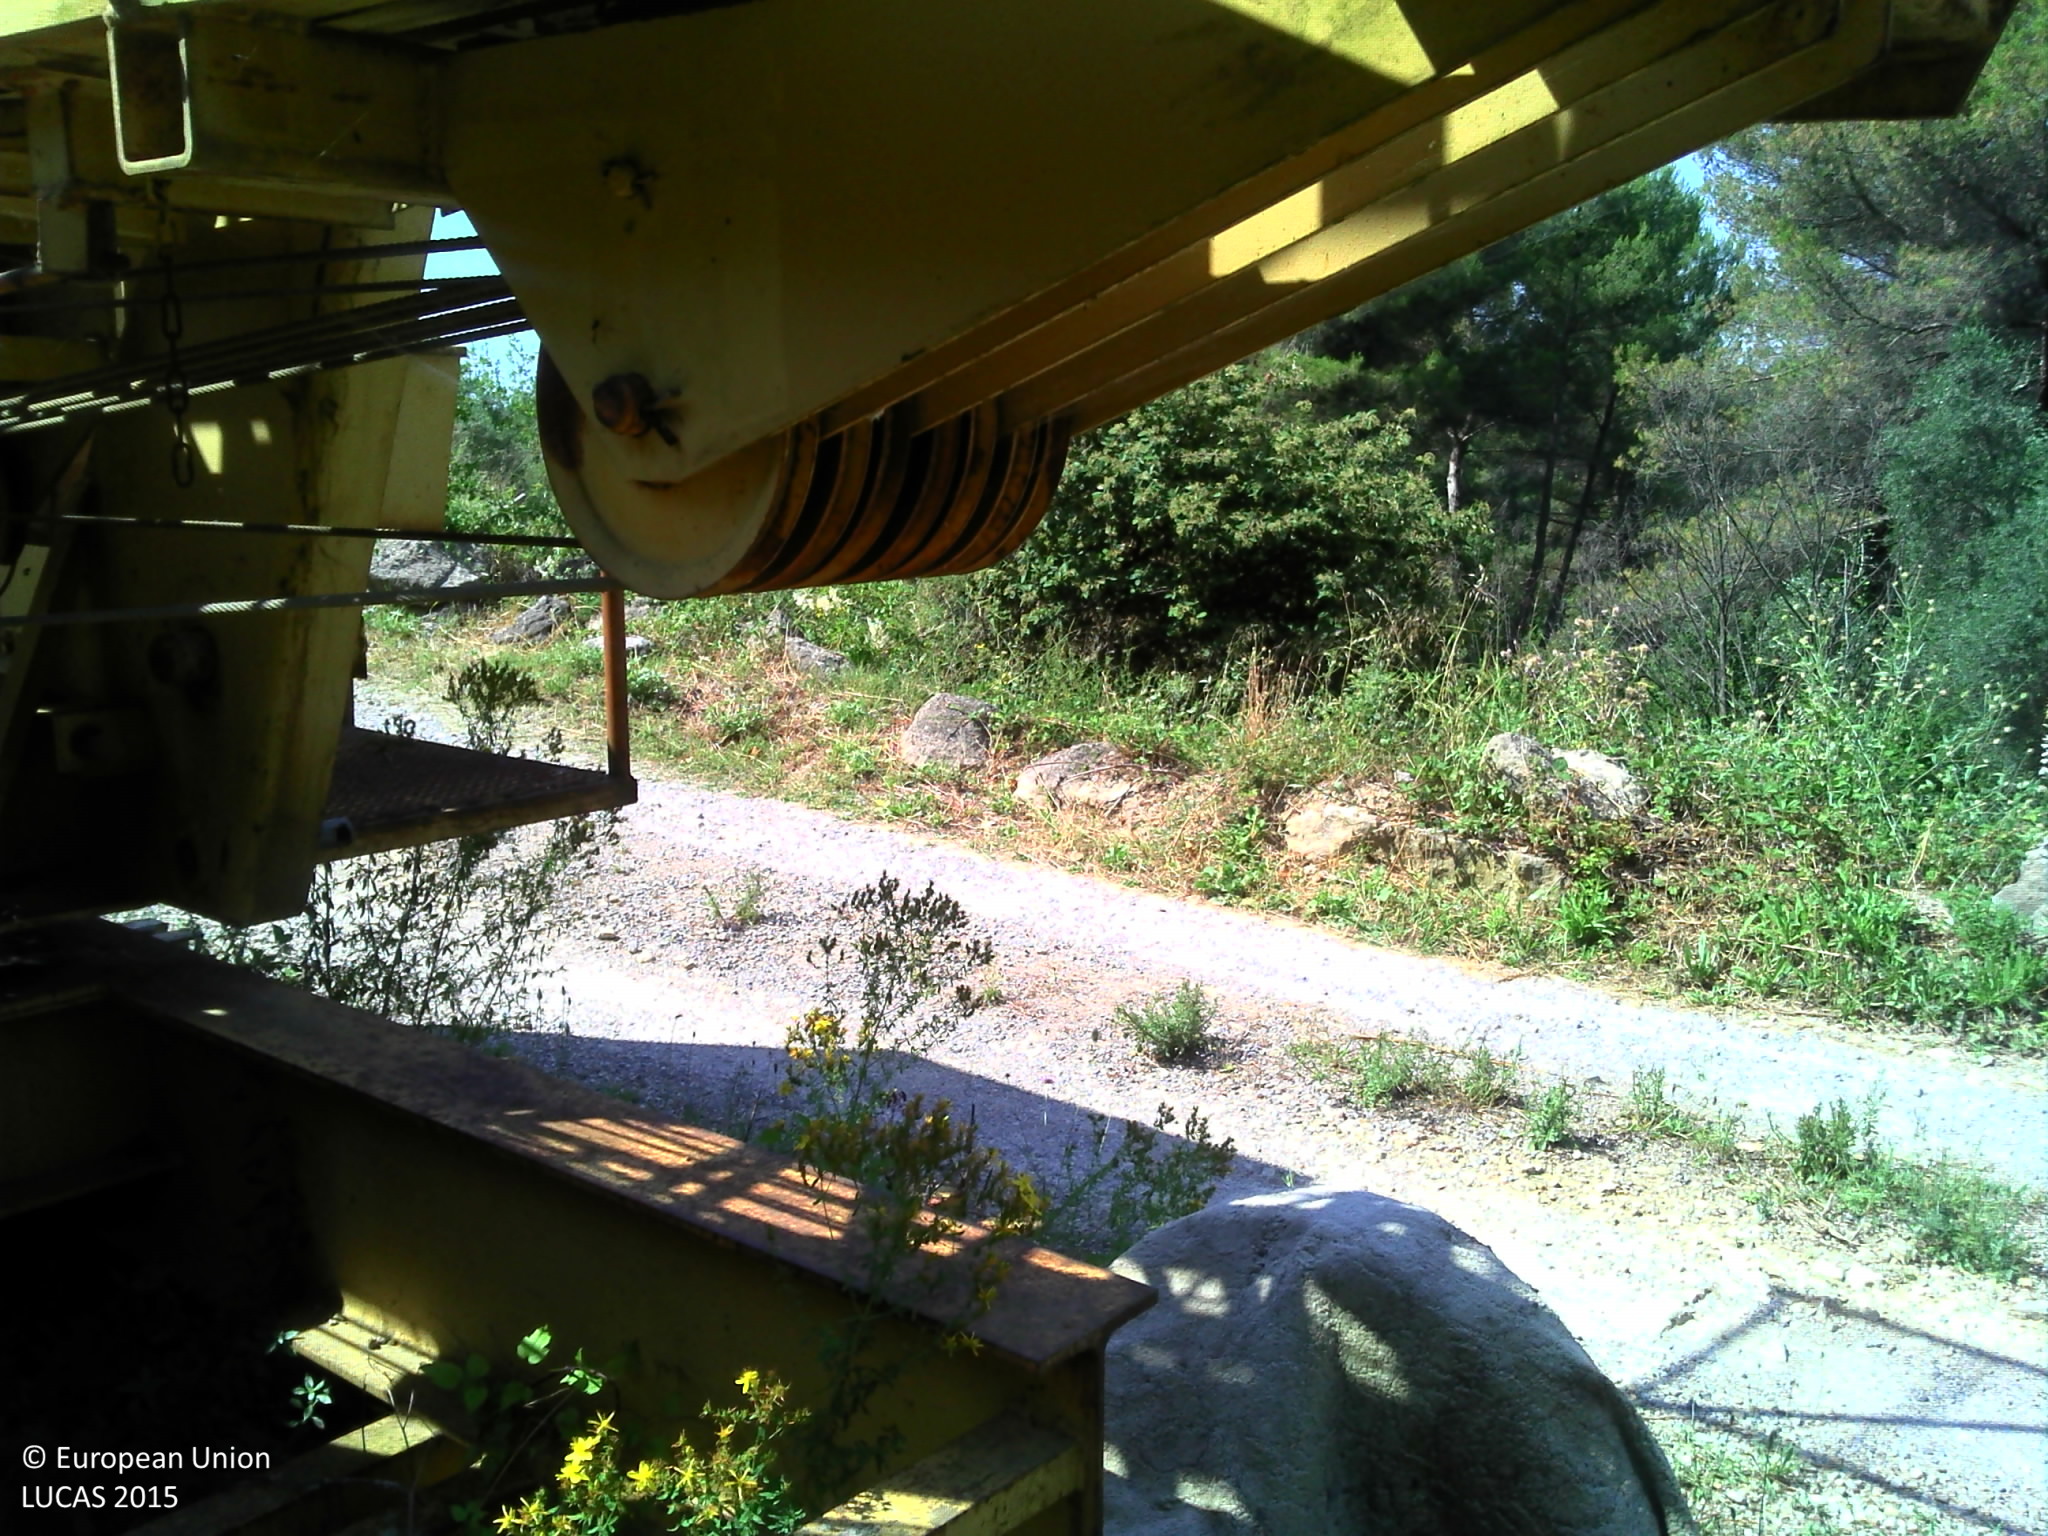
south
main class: Grassland
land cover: Spontaneously vegetated surfaces
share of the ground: > 75 %
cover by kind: herbaceous plants 80 %, consolidated bare surface 15 %, shrubs 5 %
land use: Semi-natural and natural areas not in use
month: June
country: FR
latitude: 43.7134
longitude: 7.0656
